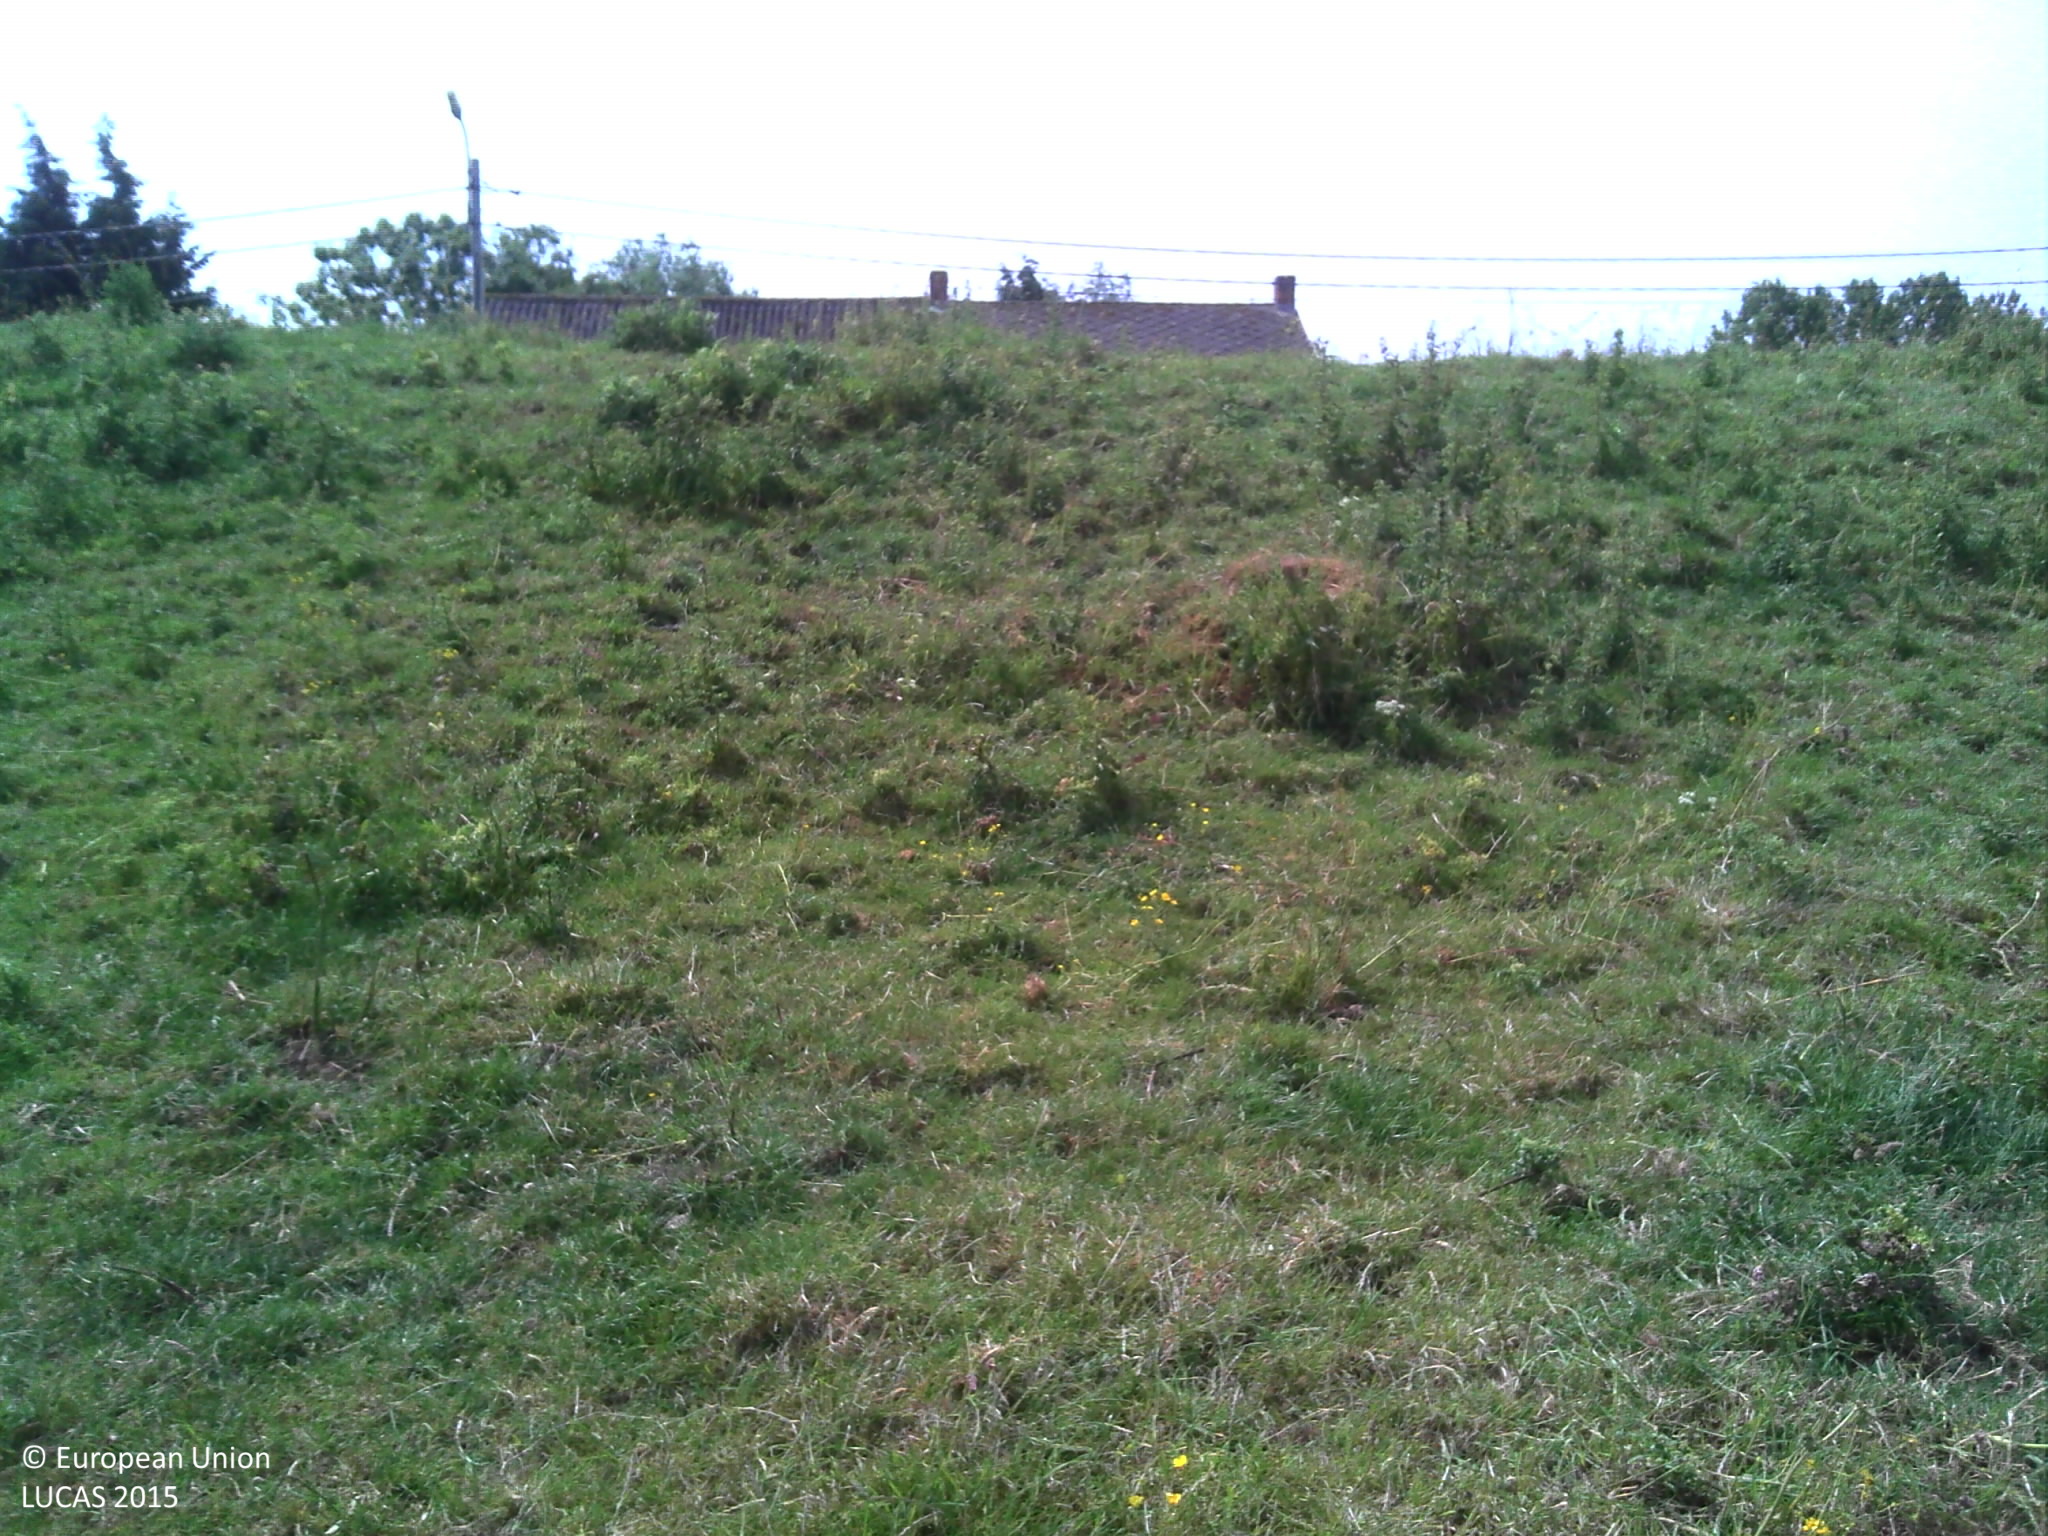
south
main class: Grassland
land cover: Spontaneously vegetated surfaces
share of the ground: > 75 %
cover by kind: herbaceous plants 100 %
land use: Semi-natural and natural areas not in use
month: June
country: BE
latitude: 51.3365
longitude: 4.2390
